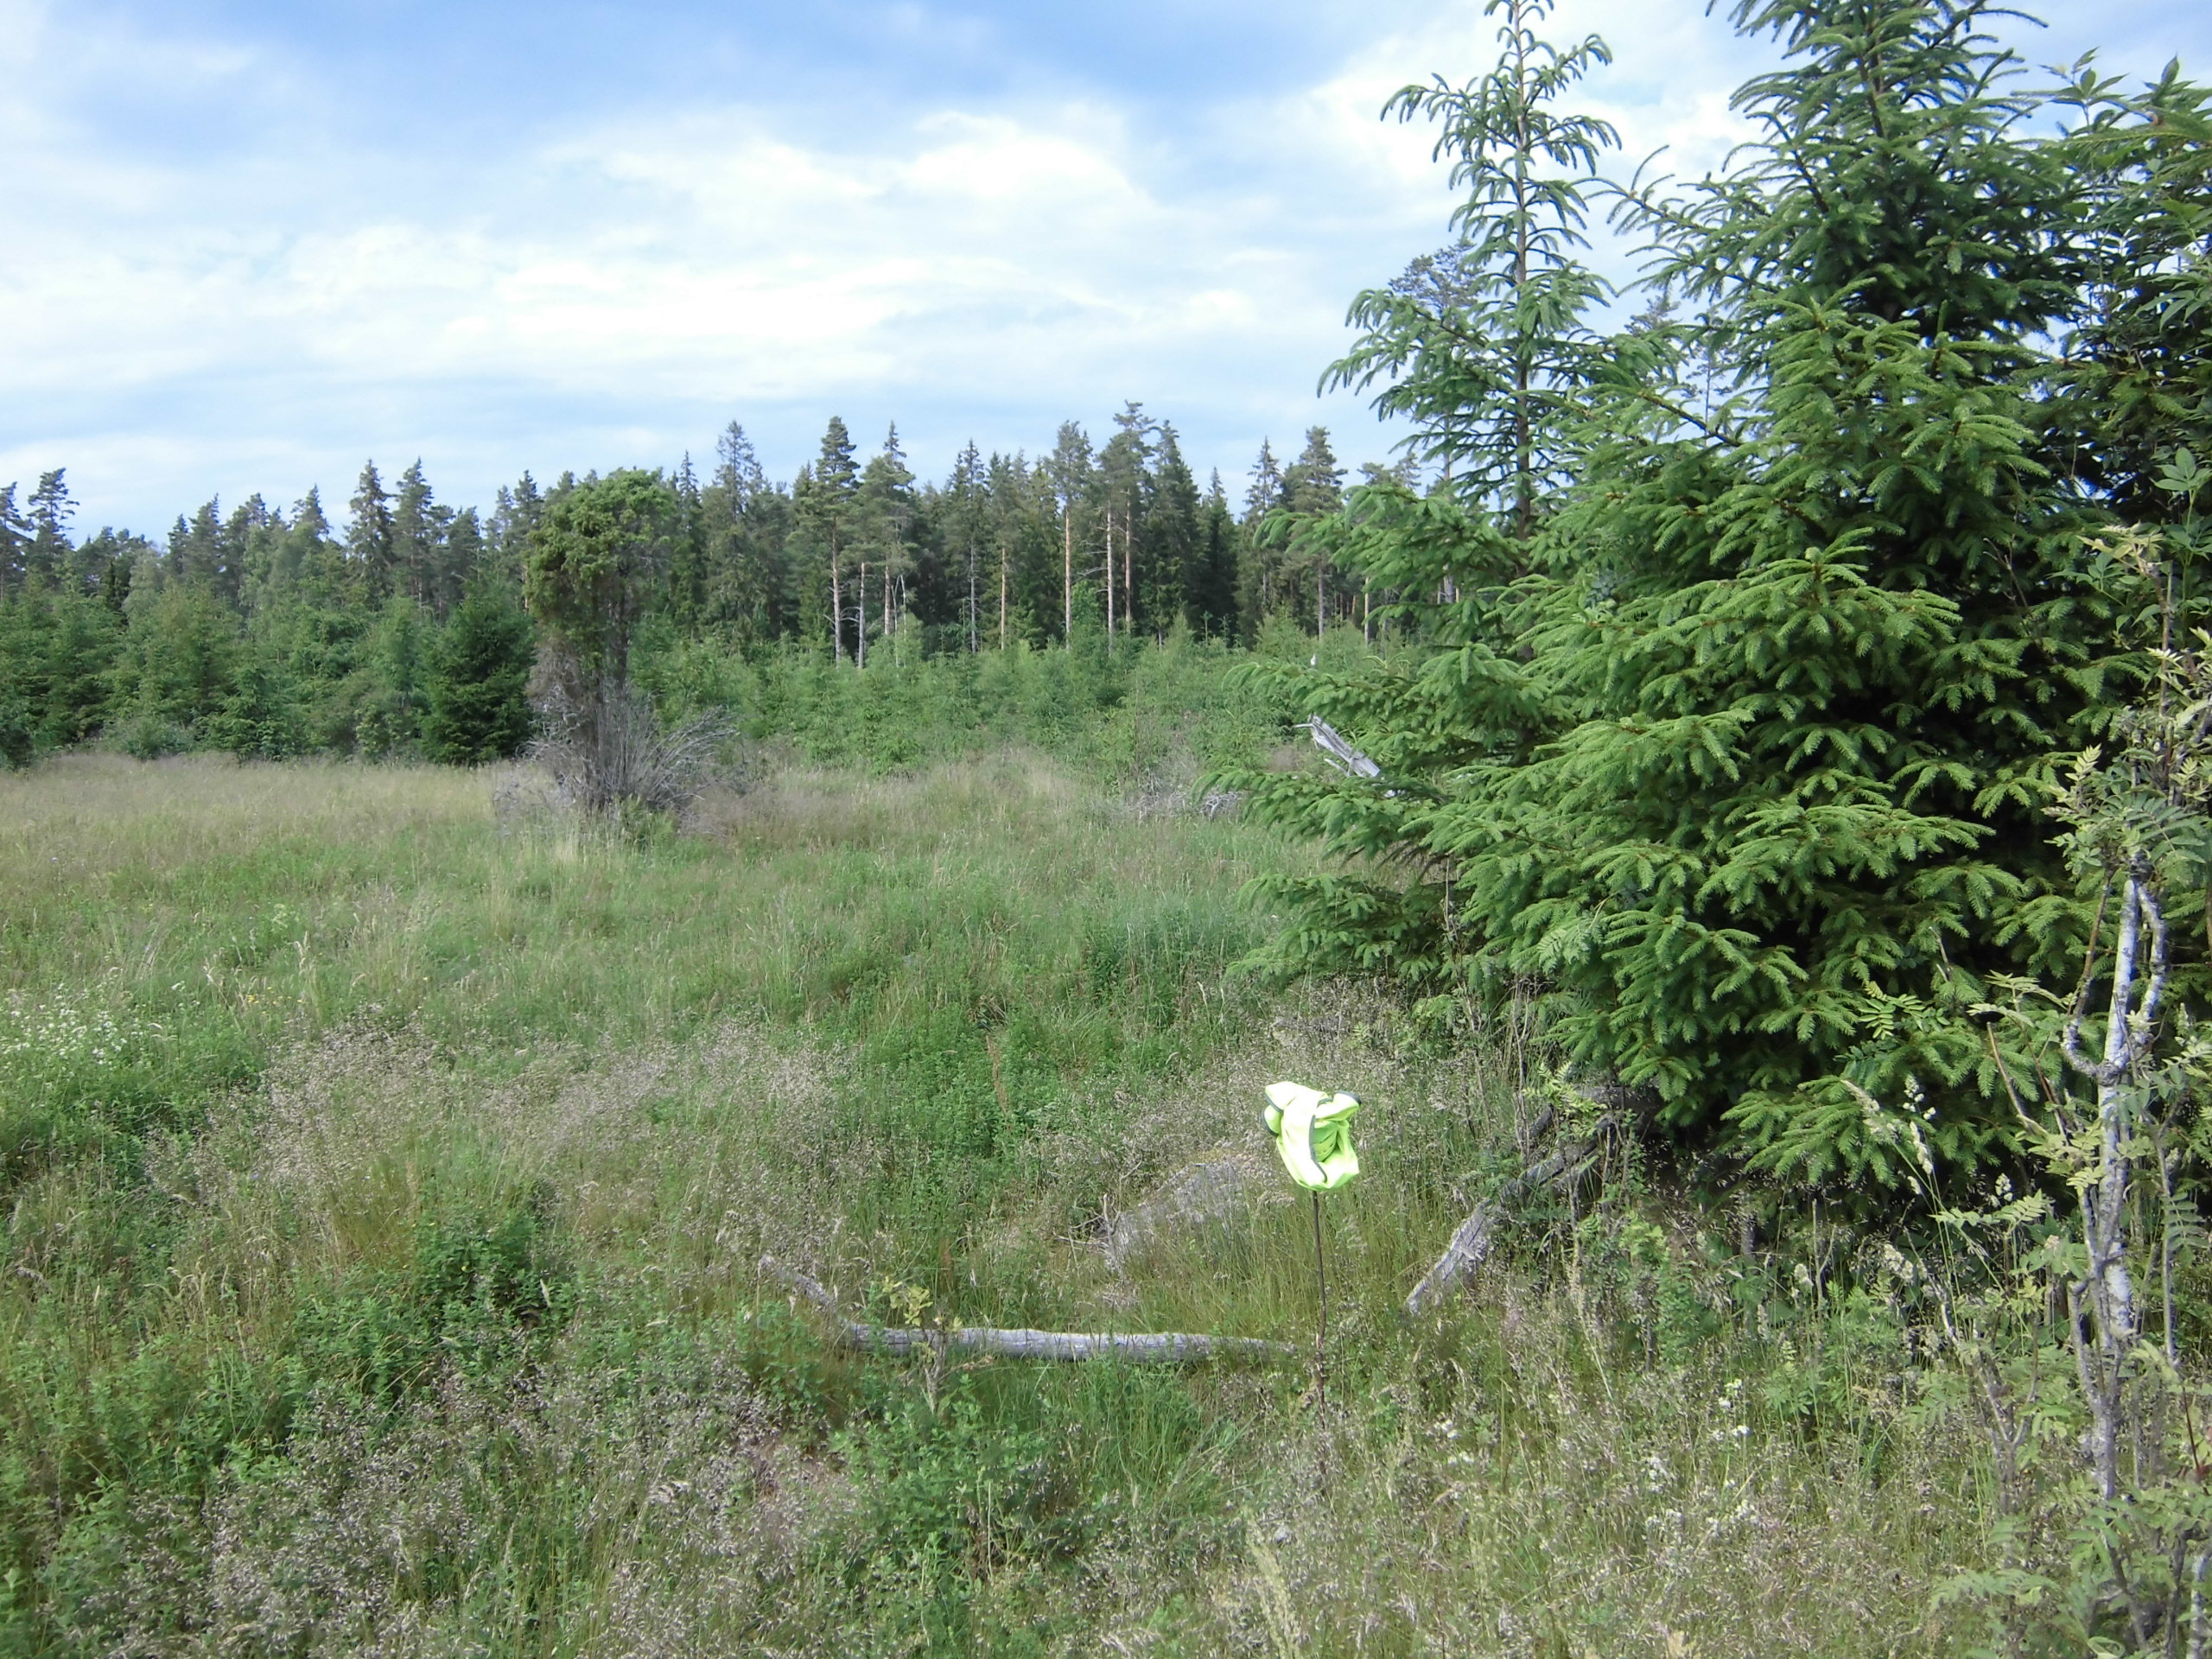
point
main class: Woodland
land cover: Spruce dominated coniferous woodland
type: boreal forest
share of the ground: 50 - 75 %
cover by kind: coniferous forest trees 50 %, herbaceous plants 35 %, broadleaved forest trees 5 %, shrubs 5 %, lichens and mosses 5 %
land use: Forestry
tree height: < 5 m
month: July
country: SE
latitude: 57.2966
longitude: 14.5265
